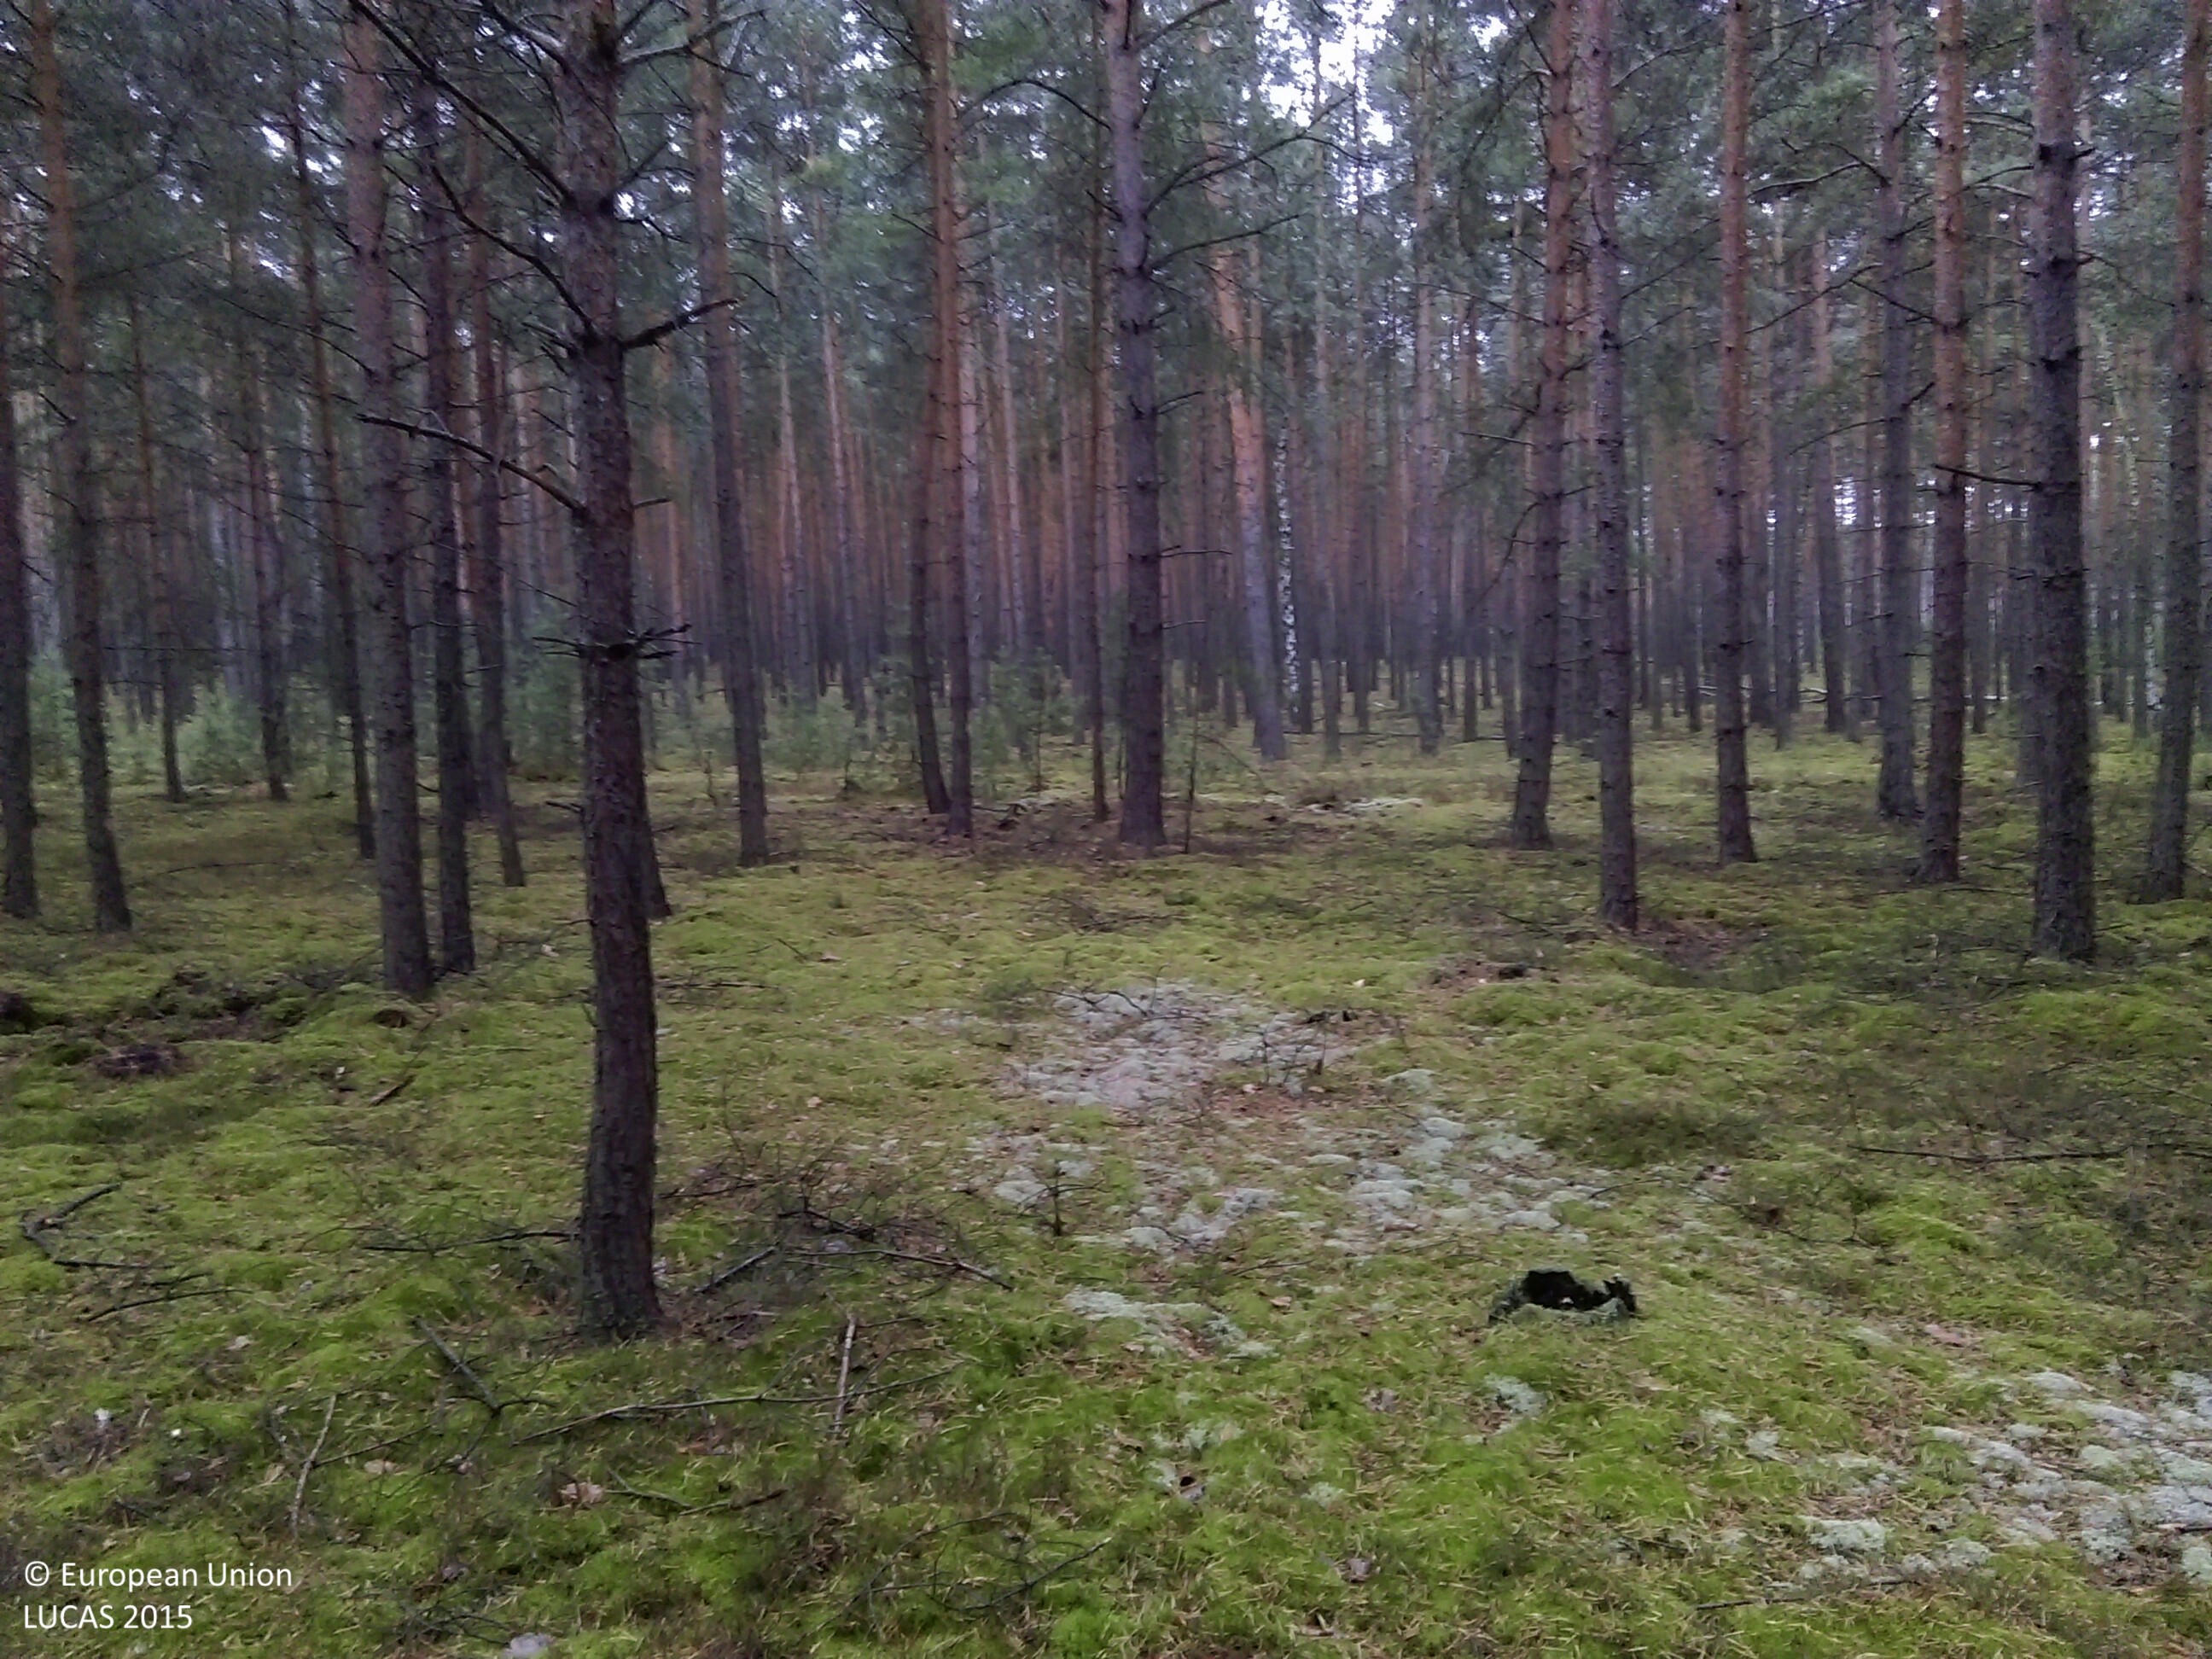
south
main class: Woodland
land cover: Pine dominated coniferous woodland
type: hemiboreal forest and nemoral coniferous forest and mixed broadleaved-coniferous forest
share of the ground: > 75 %
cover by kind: coniferous forest trees 85 %, lichens and mosses 15 %
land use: Forestry
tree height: > 5 m
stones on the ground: < 10 %
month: November
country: PL
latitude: 51.9581
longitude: 15.5778
